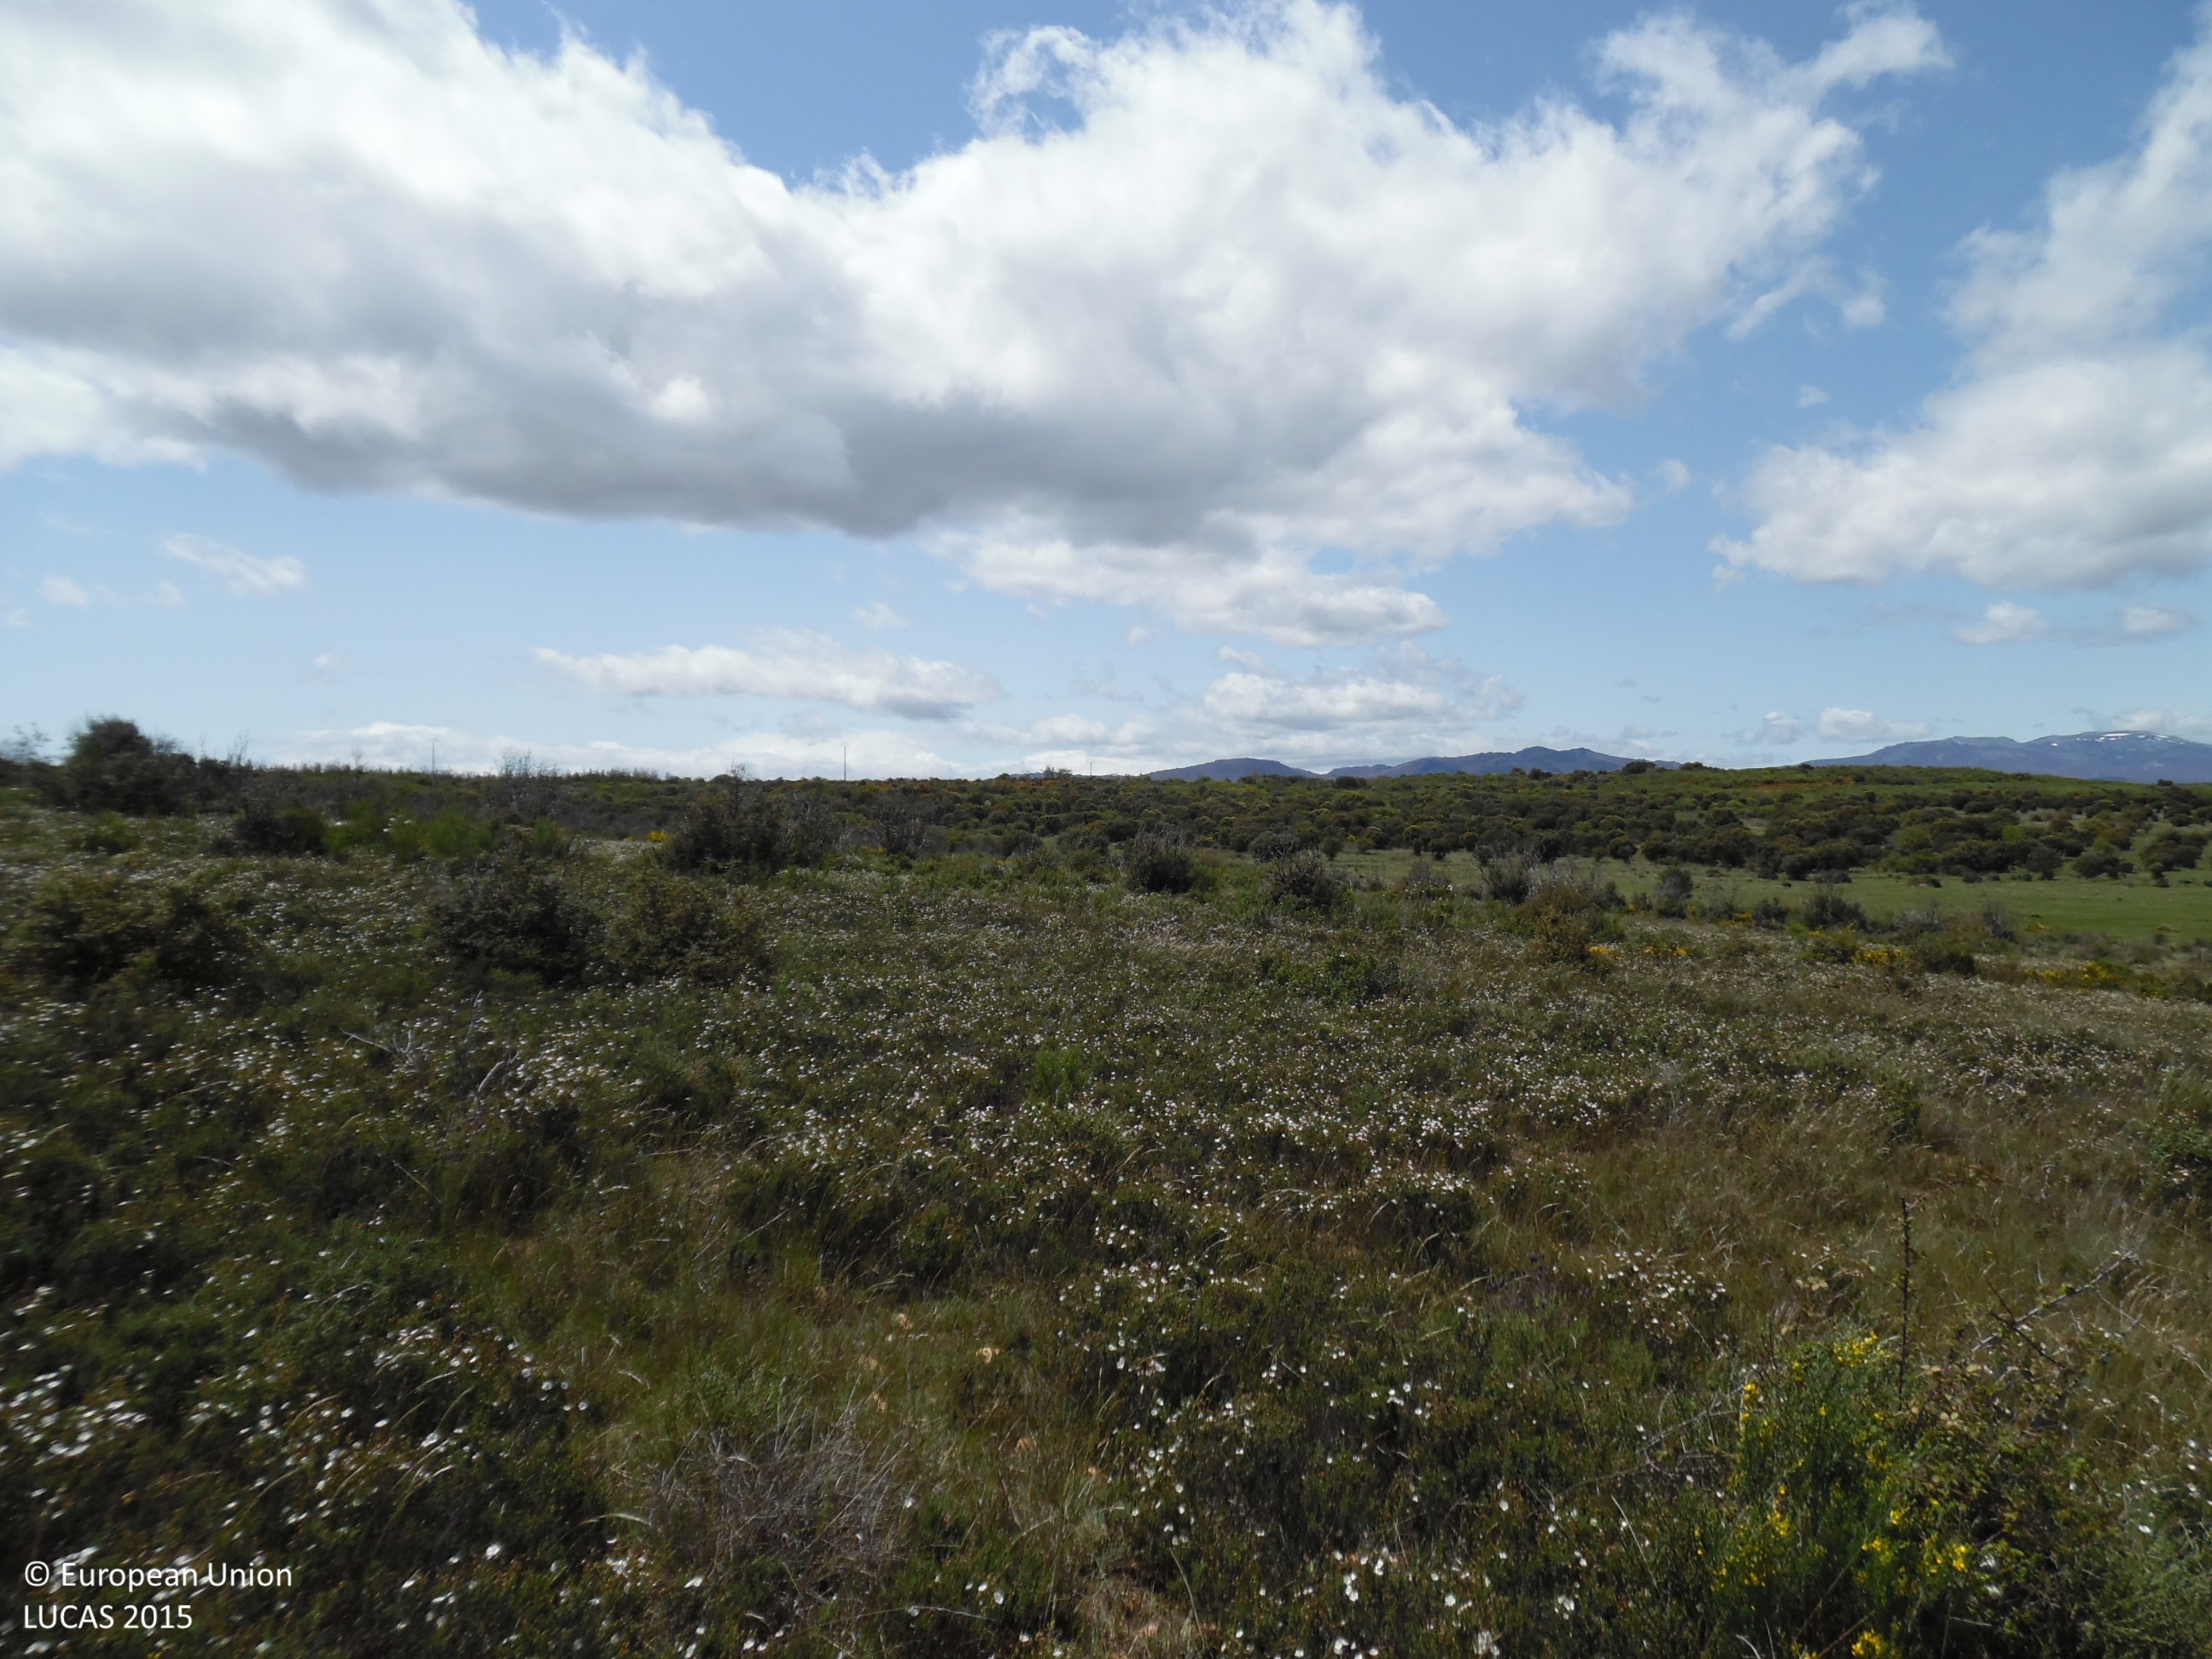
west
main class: Shrubland
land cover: Shrubland without tree cover
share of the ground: > 75 %
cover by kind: shrubs 90 %, herbaceous plants 10 %
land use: Abandoned areas
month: May
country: ES
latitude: 42.3283
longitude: -6.1120
